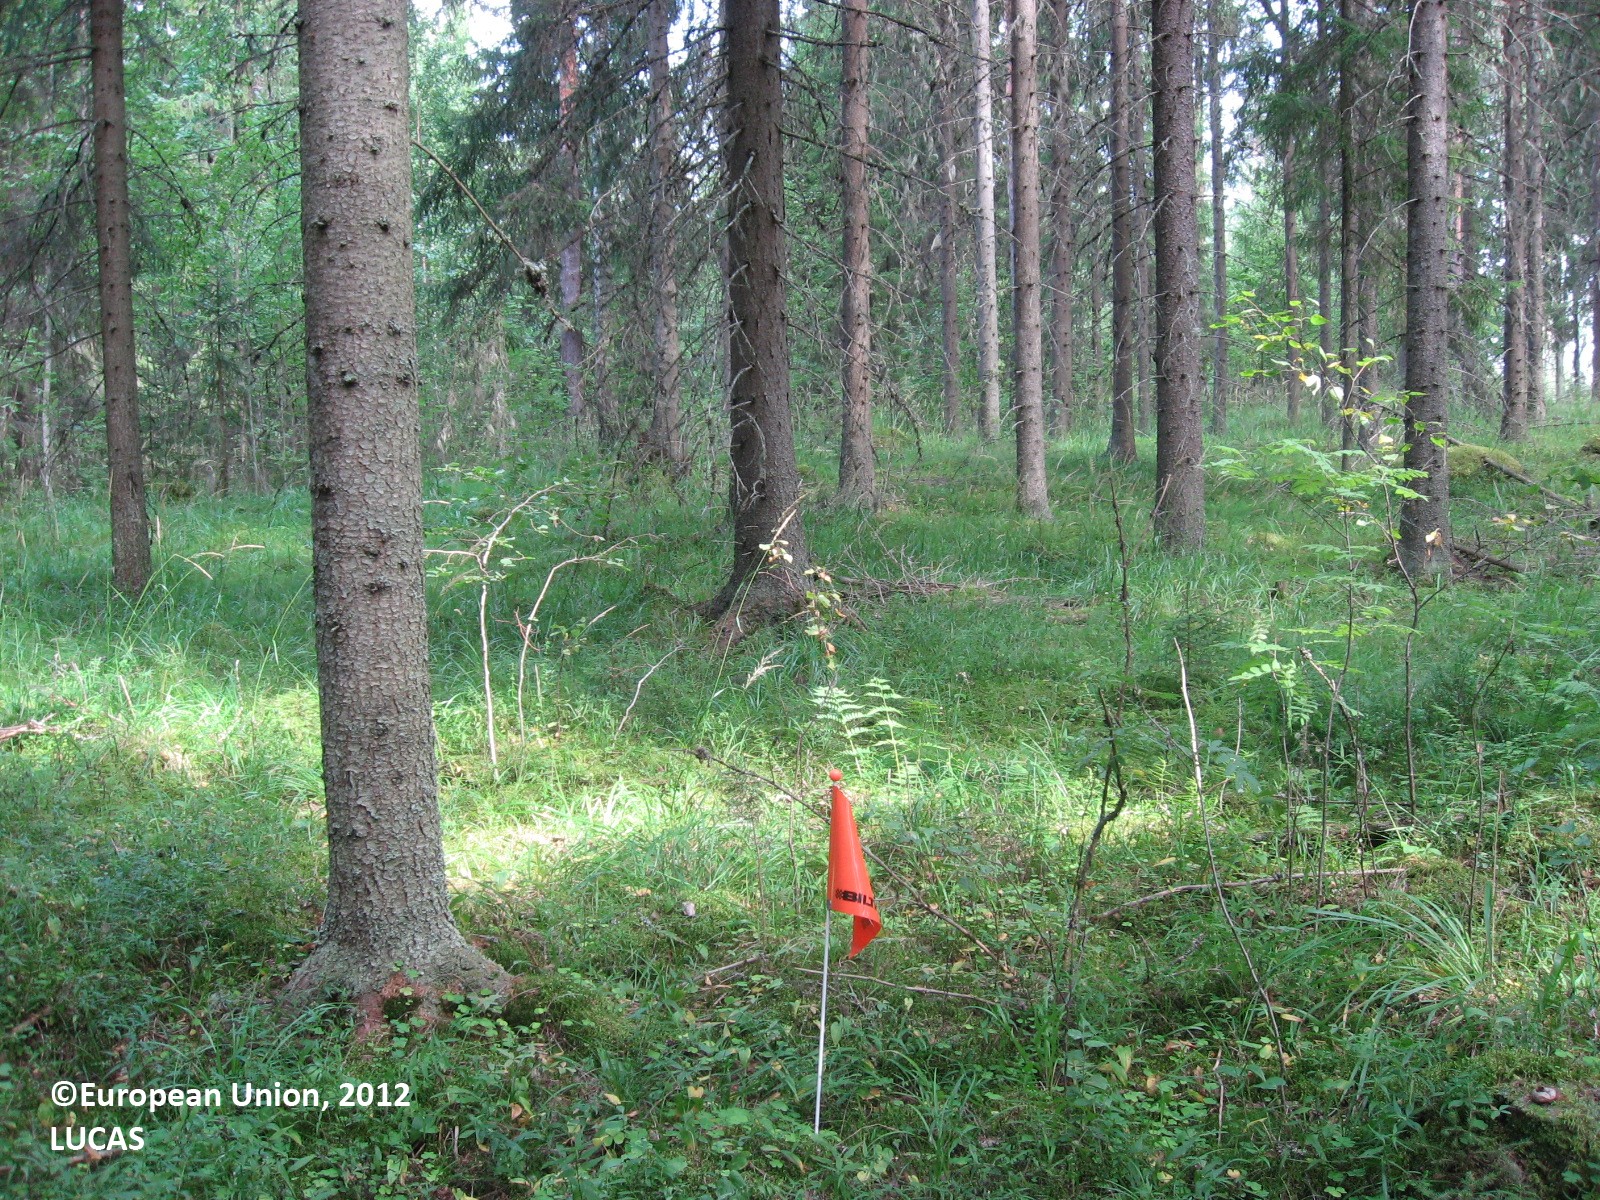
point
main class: Woodland
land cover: Spruce dominated coniferous woodland
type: boreal forest
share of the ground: 50 - 75 %
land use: Forestry
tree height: > 5 m
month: August
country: FI
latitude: 61.6143
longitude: 24.8311
